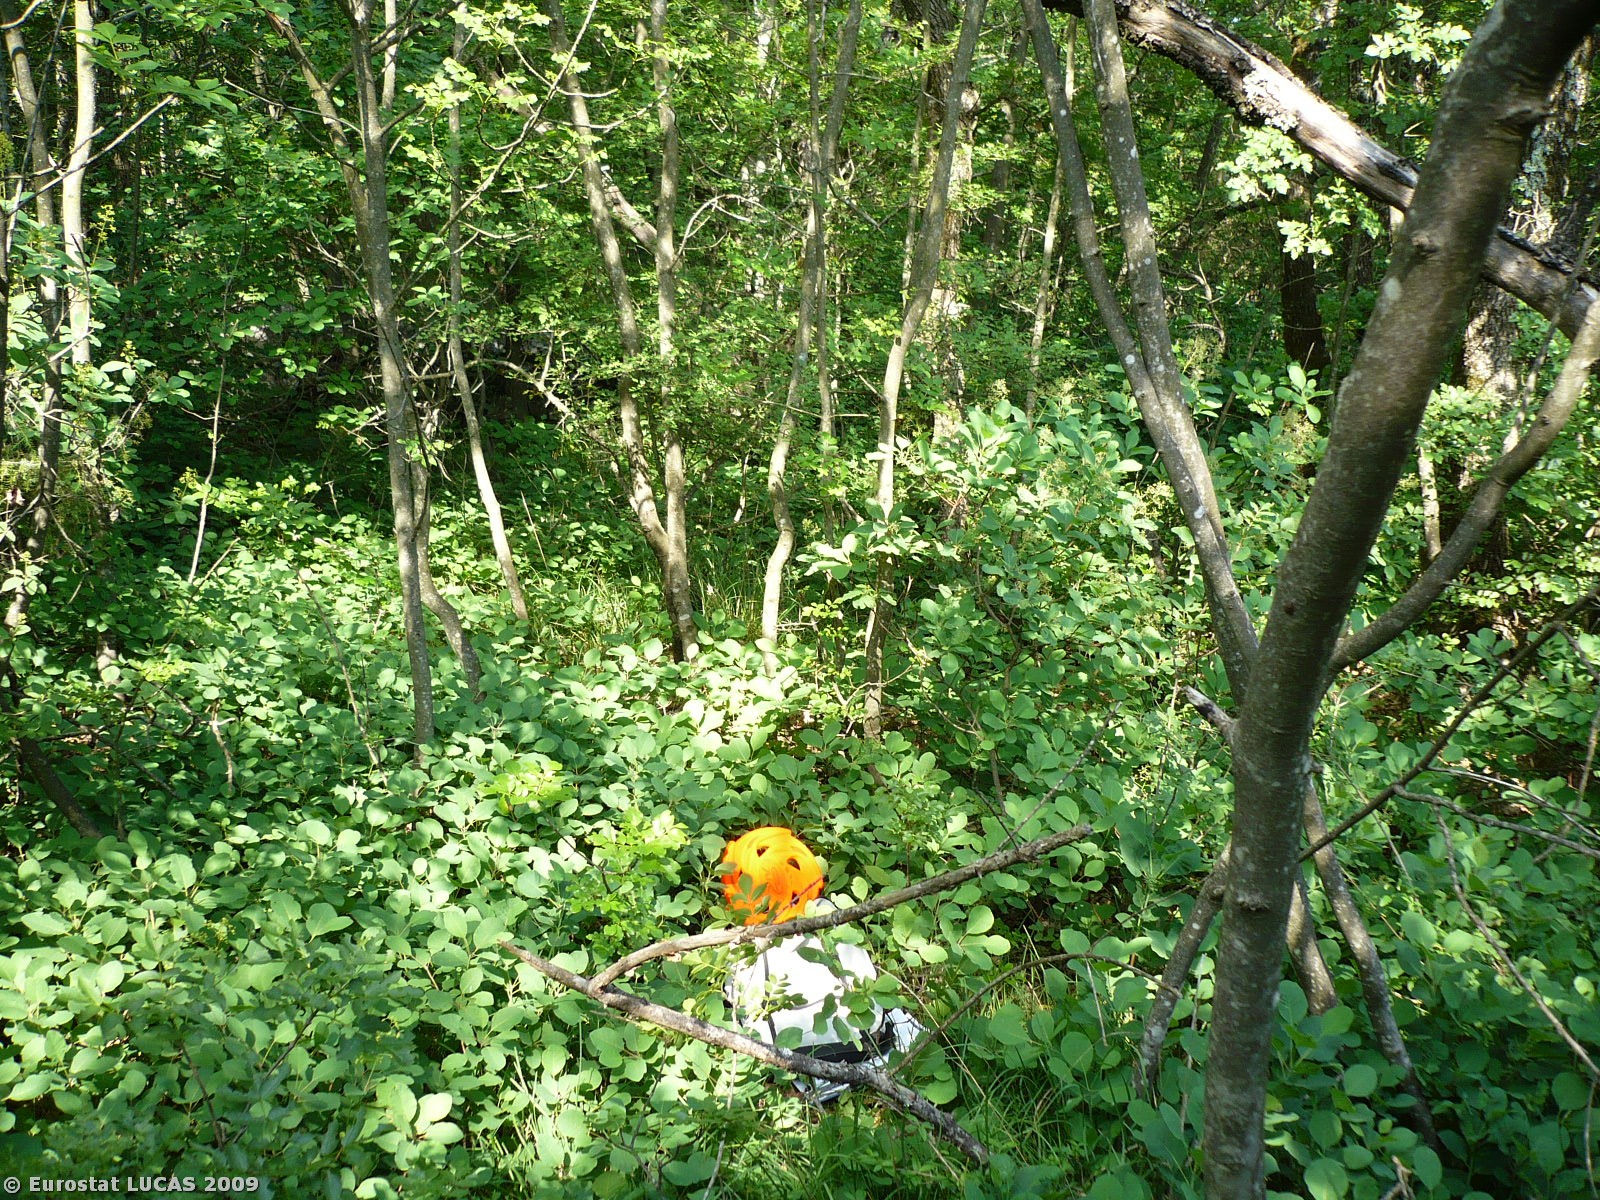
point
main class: Woodland
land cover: Broadleaved woodland
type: thermophilous deciduous forest
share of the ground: > 75 %
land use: Unused
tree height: > 5 m
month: May
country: SI
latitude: 45.8376
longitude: 13.6653
